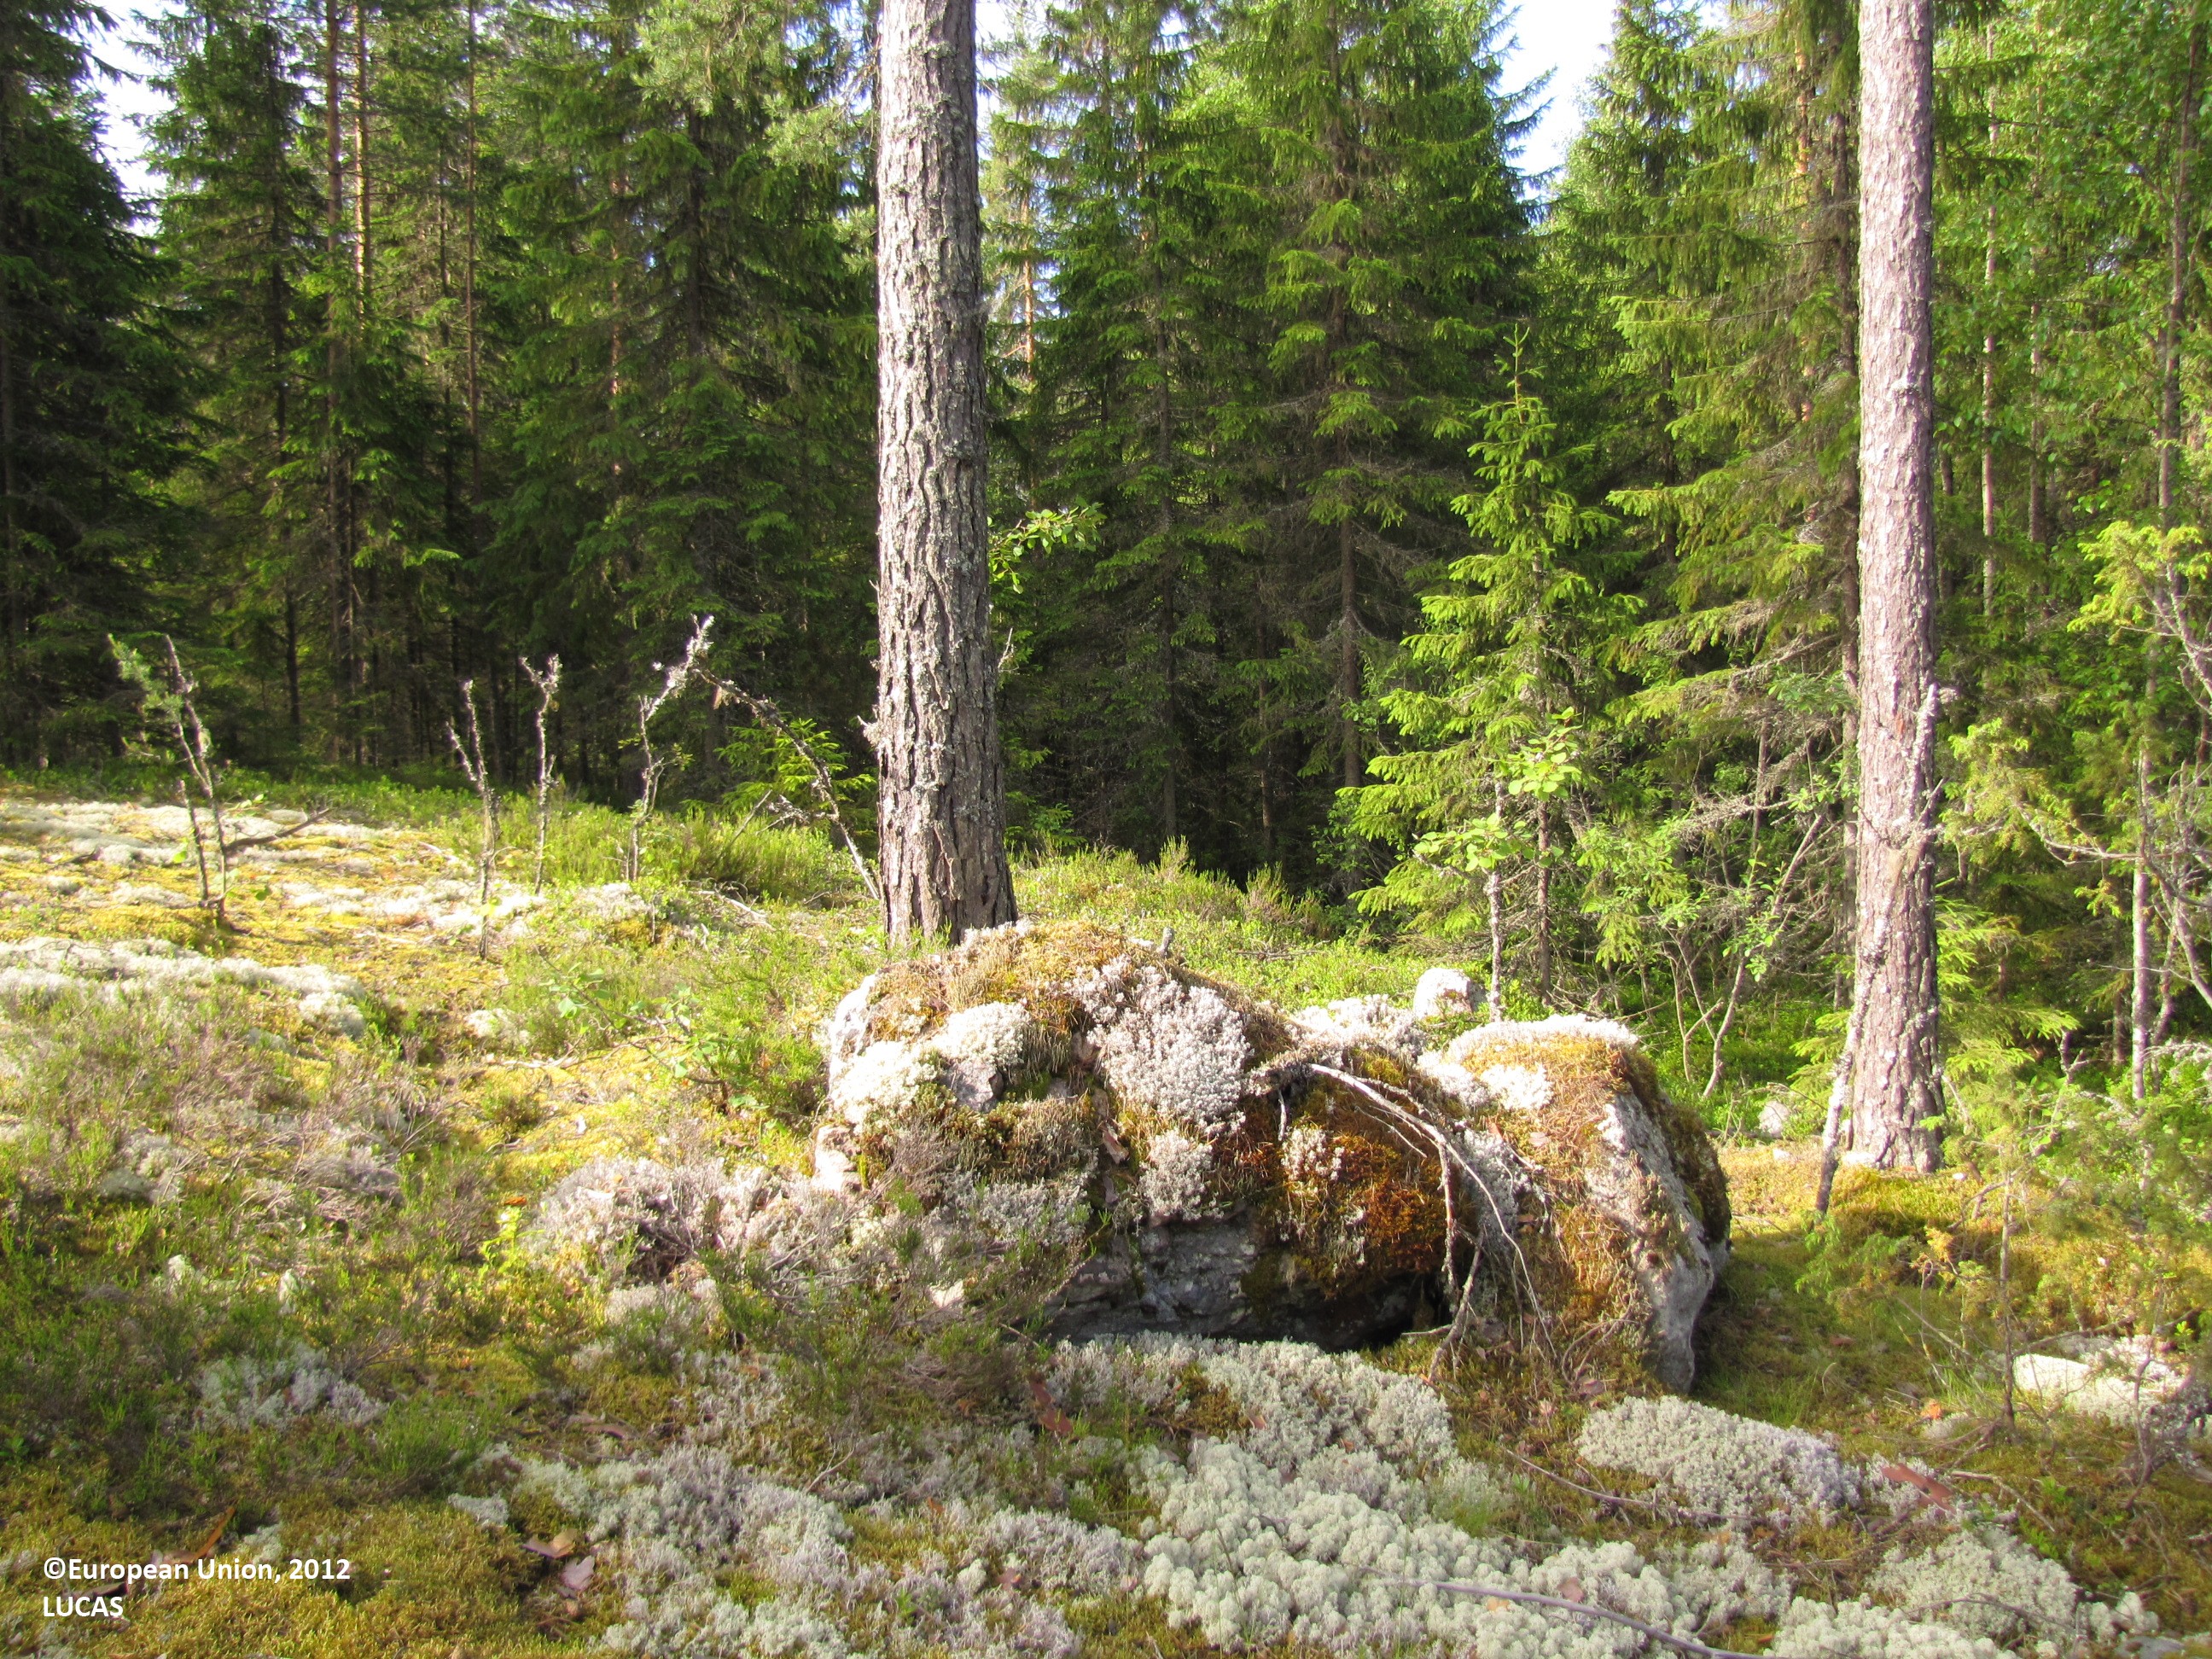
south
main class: Woodland
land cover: Pine dominated coniferous woodland
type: boreal forest
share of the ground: 50 - 75 %
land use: Forestry
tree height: > 5 m
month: June
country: FI
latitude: 61.7180
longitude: 24.5327
